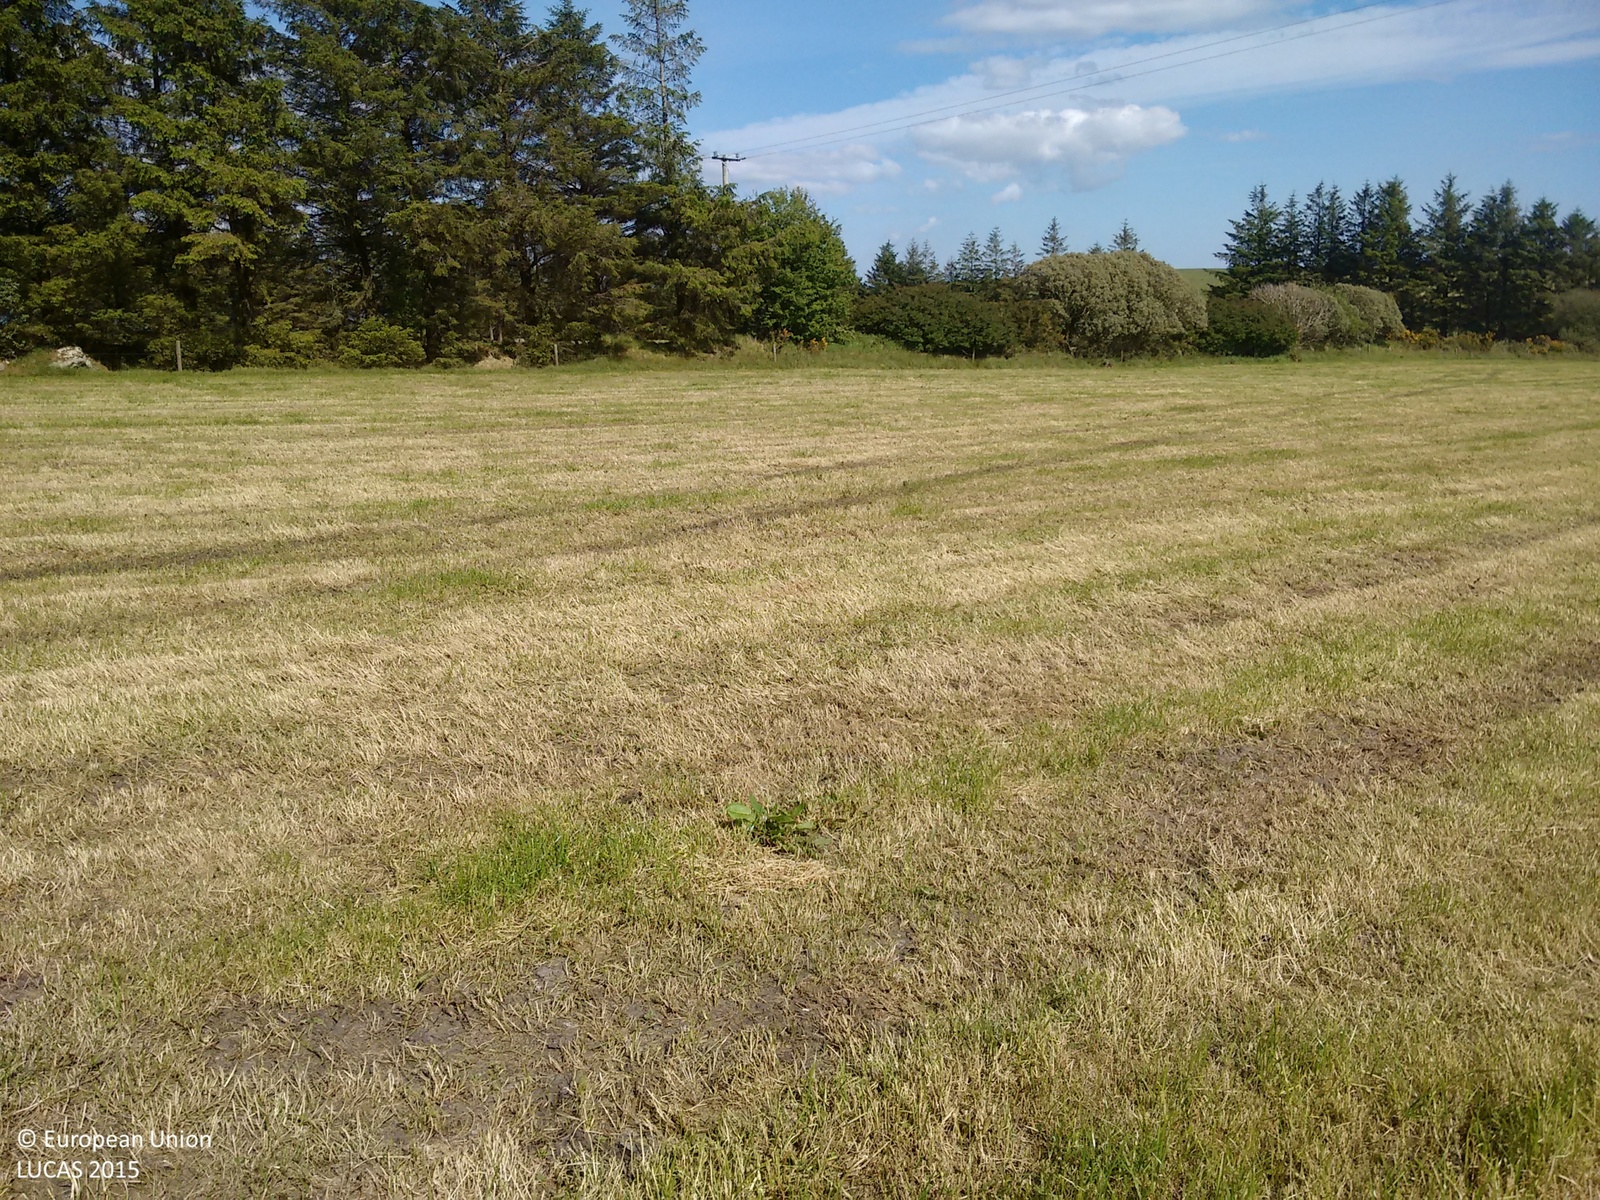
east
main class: Grassland
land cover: Grassland without tree/shrub cover
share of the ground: > 75 %
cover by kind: herbaceous plants 80 %, unconsolidated bare surface 20 %
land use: Agriculture (excluding fallow land and kitchen gardens)
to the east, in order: Grassland without tree/shrub cover; Fences; Grass margins; Spruce dominated coniferous woodland; Fences; Grassland without tree/shrub cover; Electric lines; Grassland without tree/shrub cover; Spruce dominated coniferous woodland; Dry stone walls; Ditches and canals; Fences; Grassland without tree/shrub cover
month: June
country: IE
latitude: 51.9692
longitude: -8.8836
